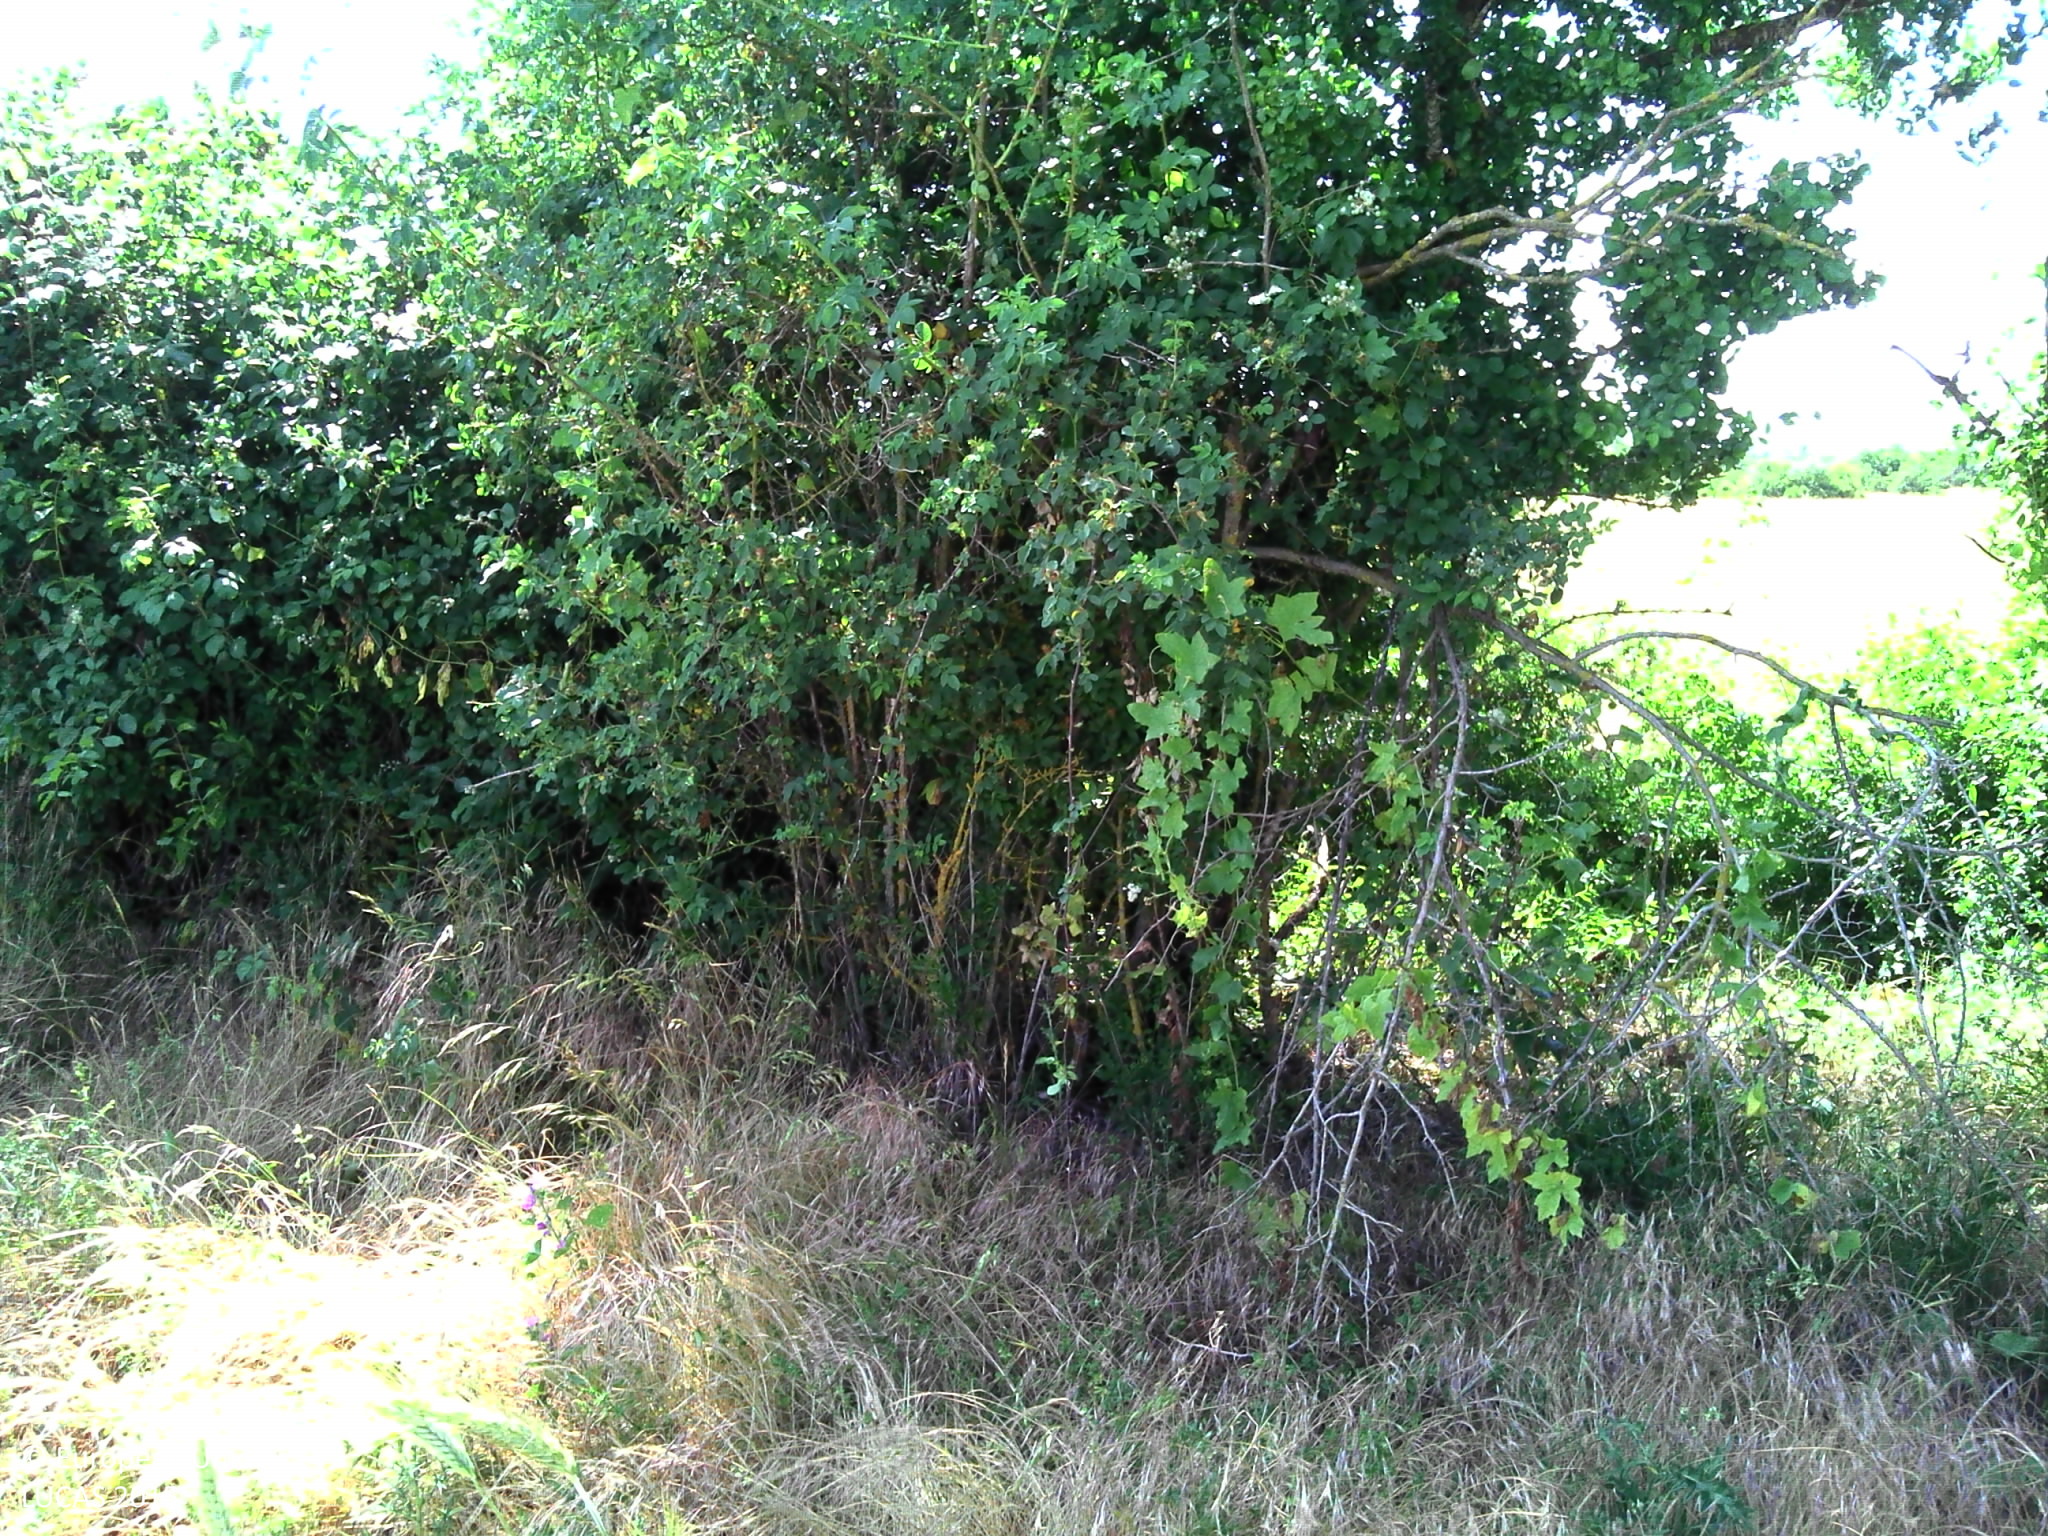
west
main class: Cropland
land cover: Triticale
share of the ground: > 75 %
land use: Agriculture (excluding fallow land and kitchen gardens)
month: June
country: FR
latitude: 44.4035
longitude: 2.4816
